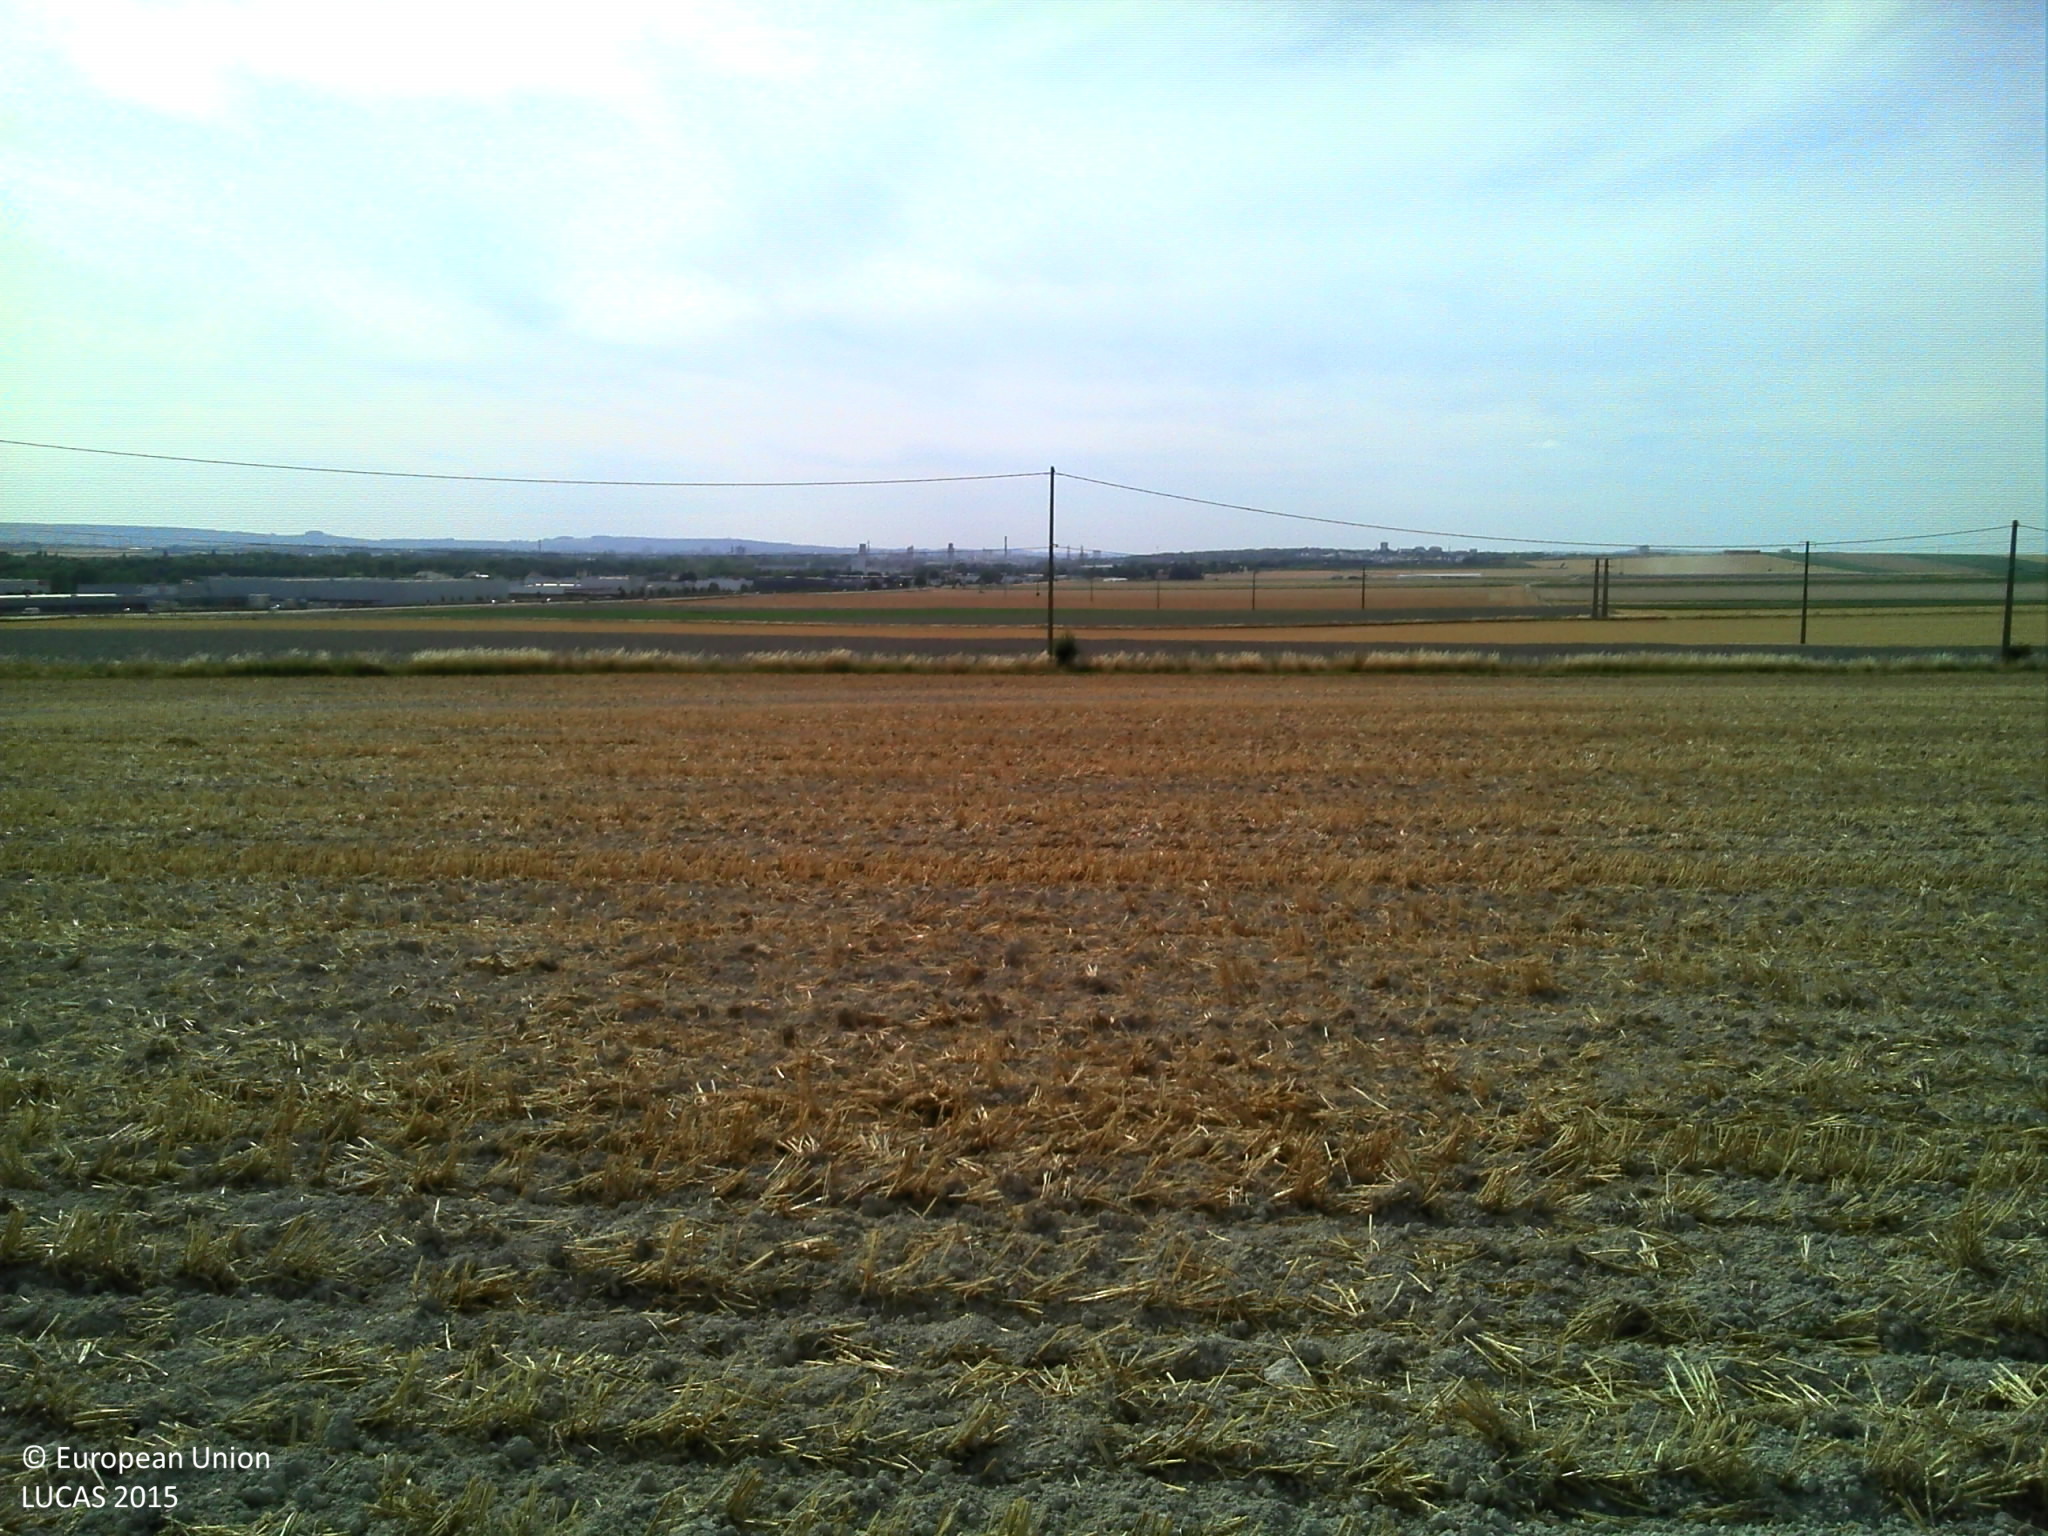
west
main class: Cropland
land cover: Common wheat
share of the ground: > 75 %
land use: Agriculture (excluding fallow land and kitchen gardens)
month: August
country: FR
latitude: 49.2217
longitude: 4.1326
